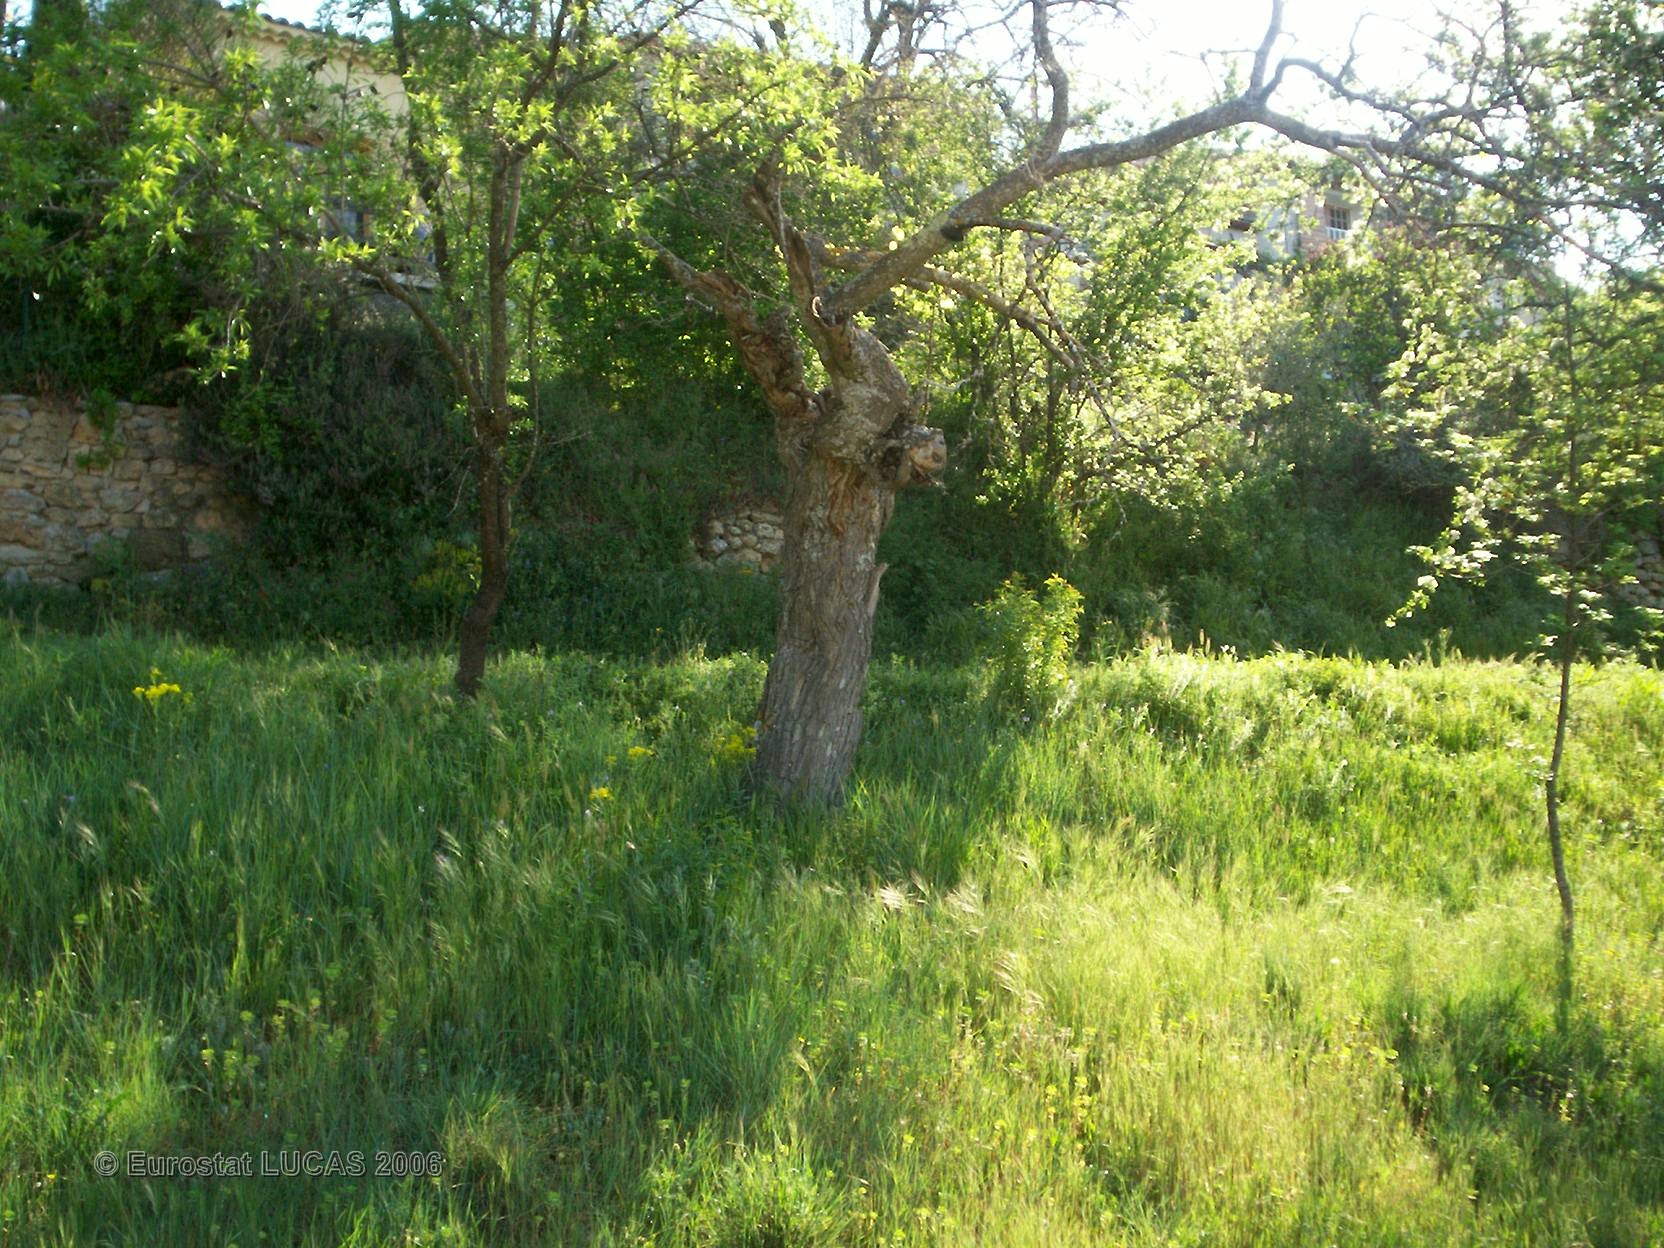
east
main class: Cropland
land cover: Other leguminous and mixtures for fodder
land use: Agriculture (excluding fallow land and kitchen gardens)
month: April
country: FR
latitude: 43.5502
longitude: 5.5412
